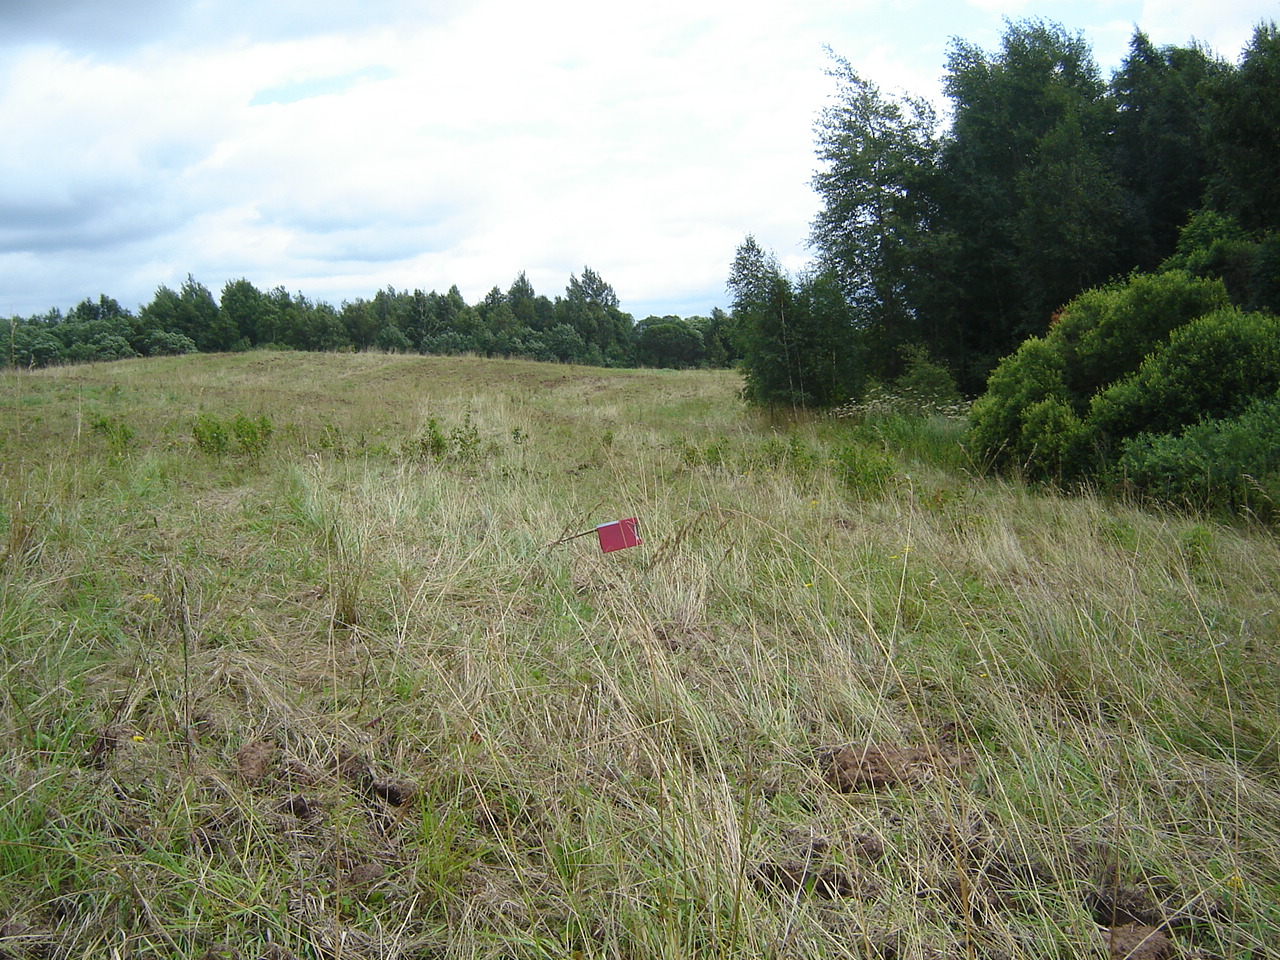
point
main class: Grassland
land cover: Spontaneously vegetated surfaces
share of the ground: > 75 %
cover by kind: herbaceous plants 95 %, shrubs 5 %
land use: Fallow land
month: July
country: LT
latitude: 55.2917
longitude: 25.0584
